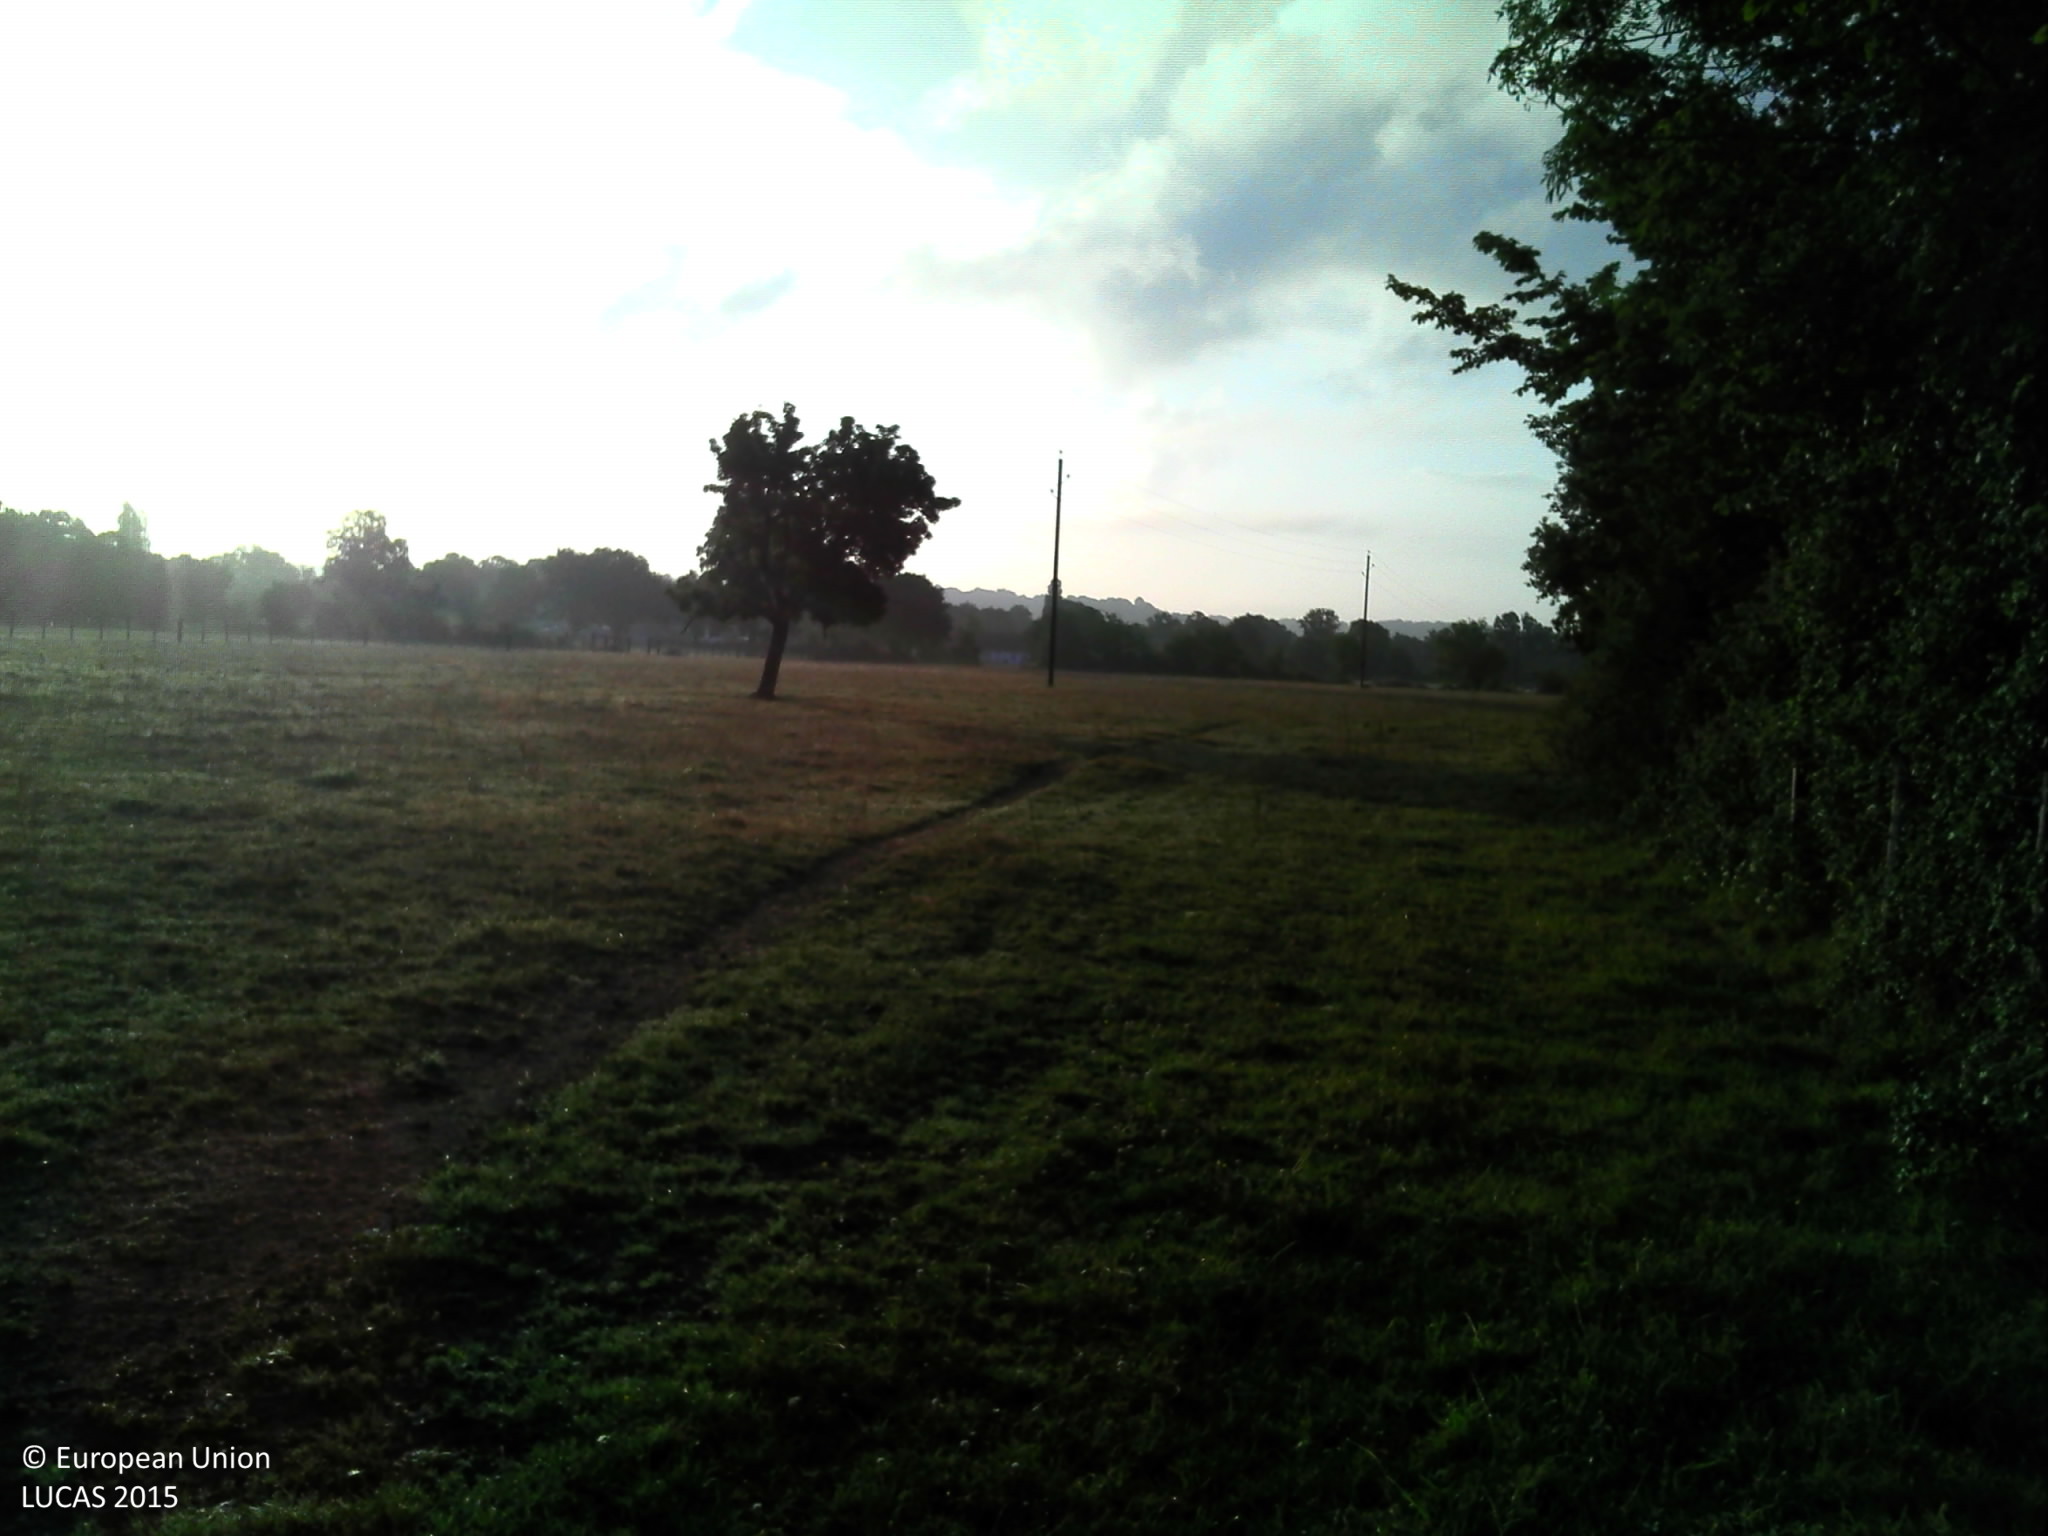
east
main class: Grassland
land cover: Grassland without tree/shrub cover
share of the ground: > 75 %
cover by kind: herbaceous plants 100 %
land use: Agriculture (excluding fallow land and kitchen gardens)
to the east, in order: Fences; Grassland without tree/shrub cover; Electric lines; Grassland without tree/shrub cover
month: July
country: FR
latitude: 49.0947
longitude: 0.0407
